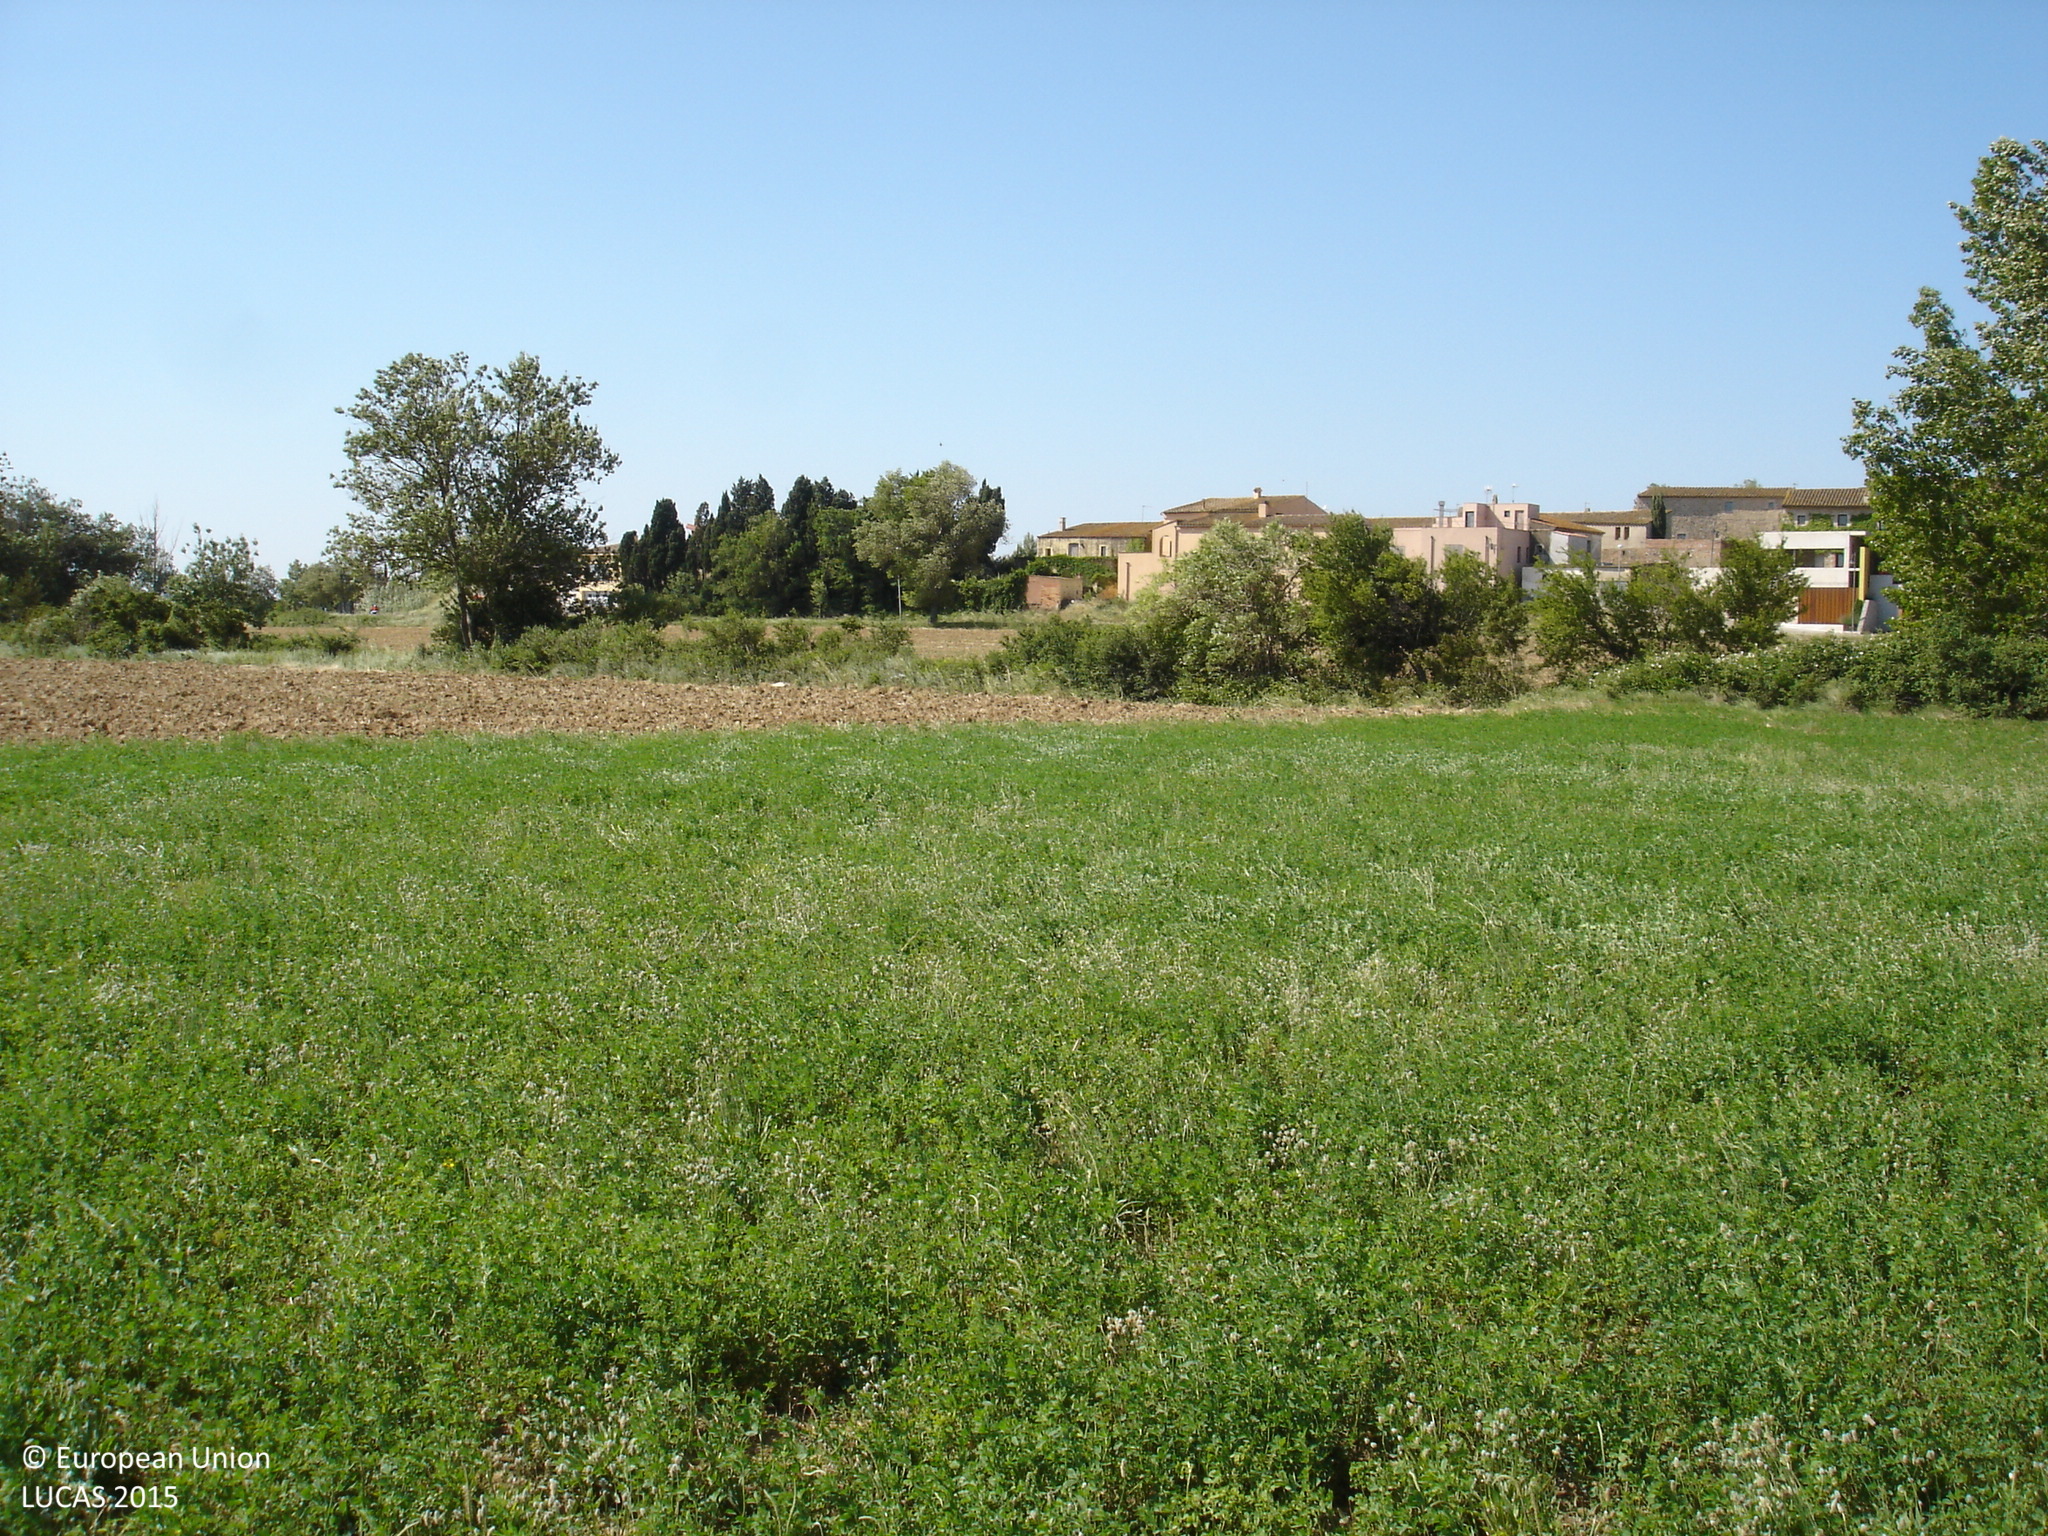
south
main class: Cropland
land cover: Lucerne
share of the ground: > 75 %
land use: Agriculture (excluding fallow land and kitchen gardens)
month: May
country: ES
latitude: 42.2484
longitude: 2.9969
